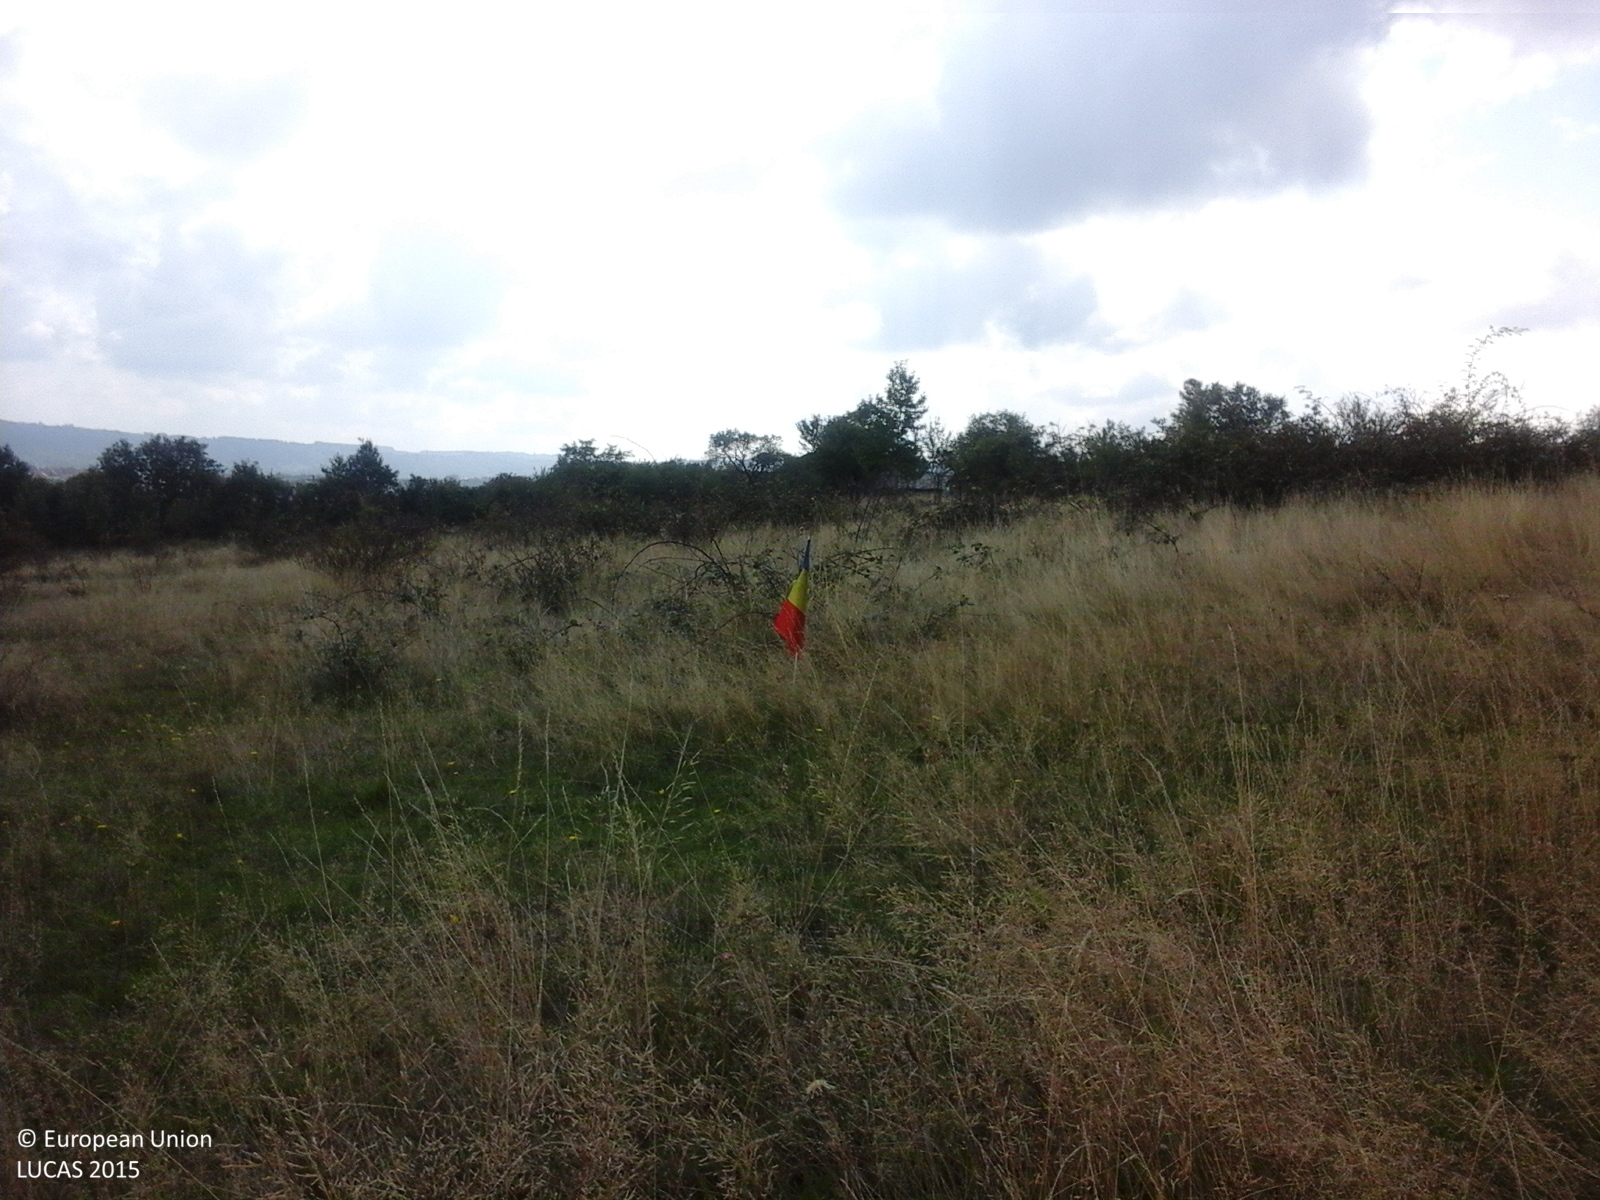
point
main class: Grassland
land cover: Grassland with sparse tree/shrub cover
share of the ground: > 75 %
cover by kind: herbaceous plants 95 %, broadleaved forest trees 5 %
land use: Agriculture (excluding fallow land and kitchen gardens)
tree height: > 5 m
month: September
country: RO
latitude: 45.1502
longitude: 23.4509
